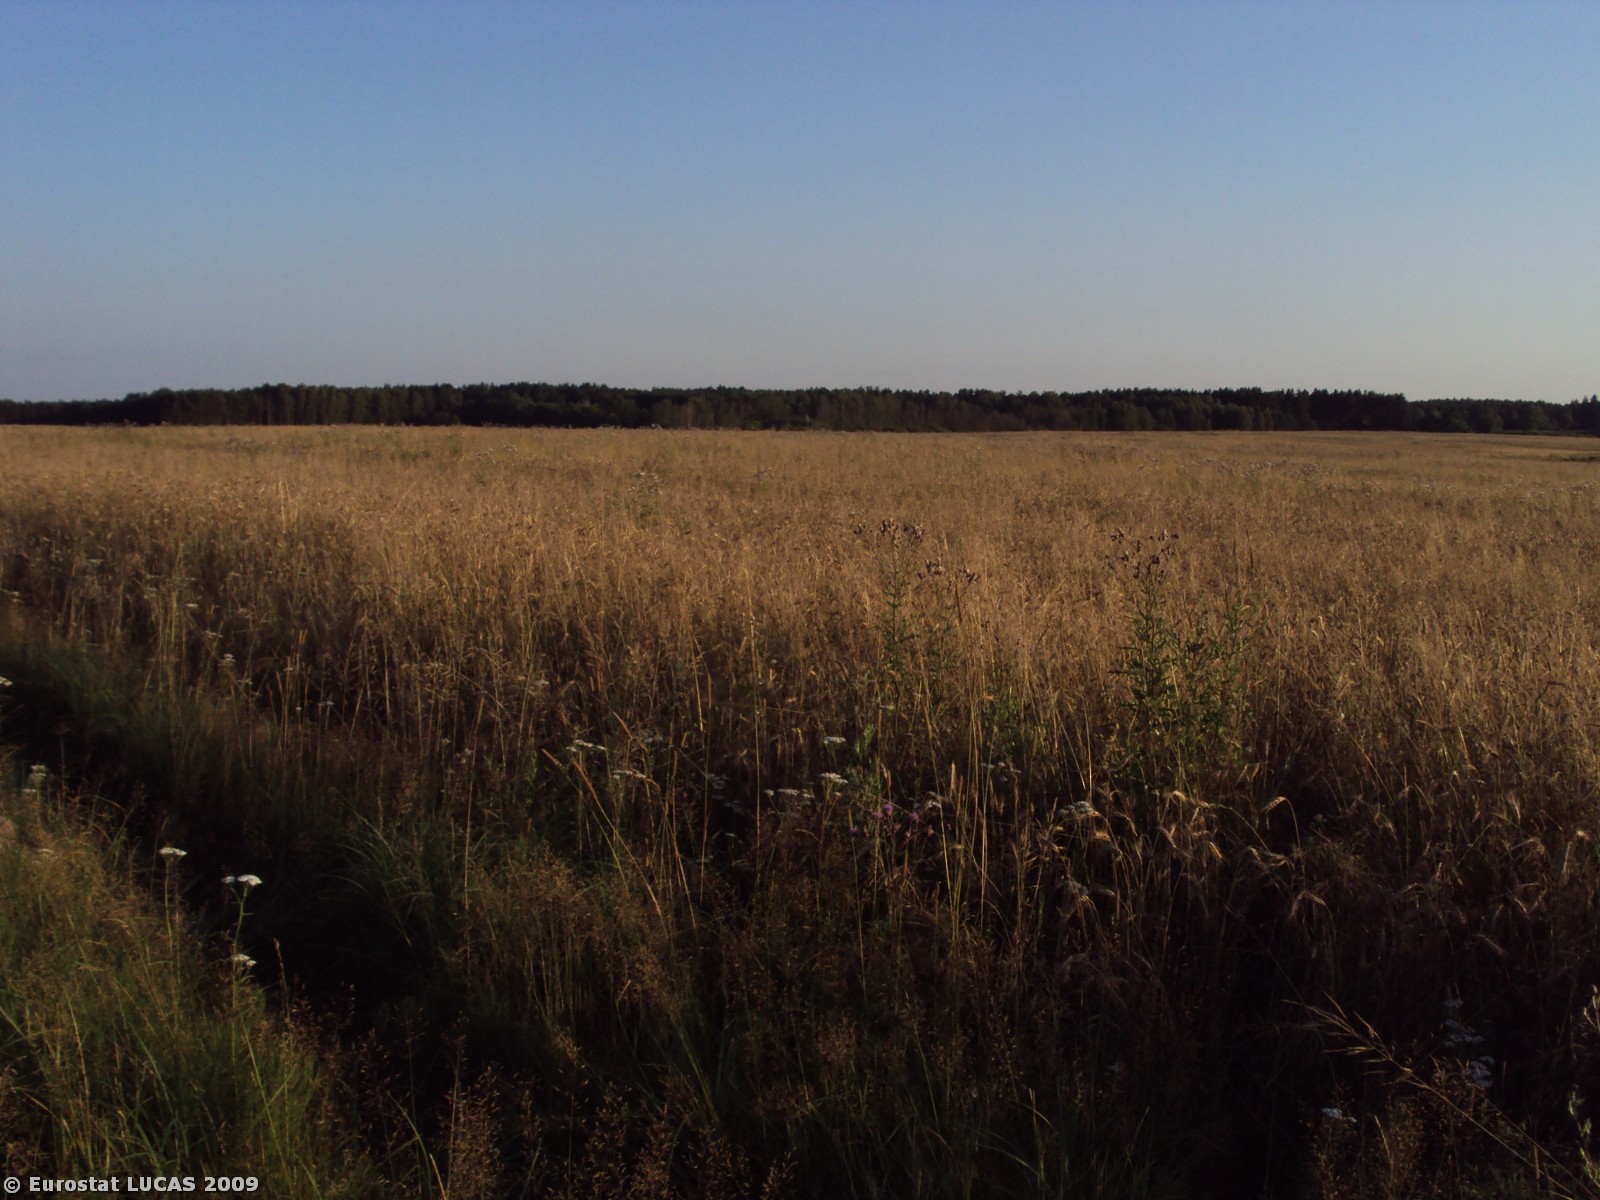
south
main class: Cropland
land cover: Triticale
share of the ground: > 75 %
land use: Agriculture (excluding fallow land and kitchen gardens)
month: August
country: PL
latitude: 53.3318
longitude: 16.5693
